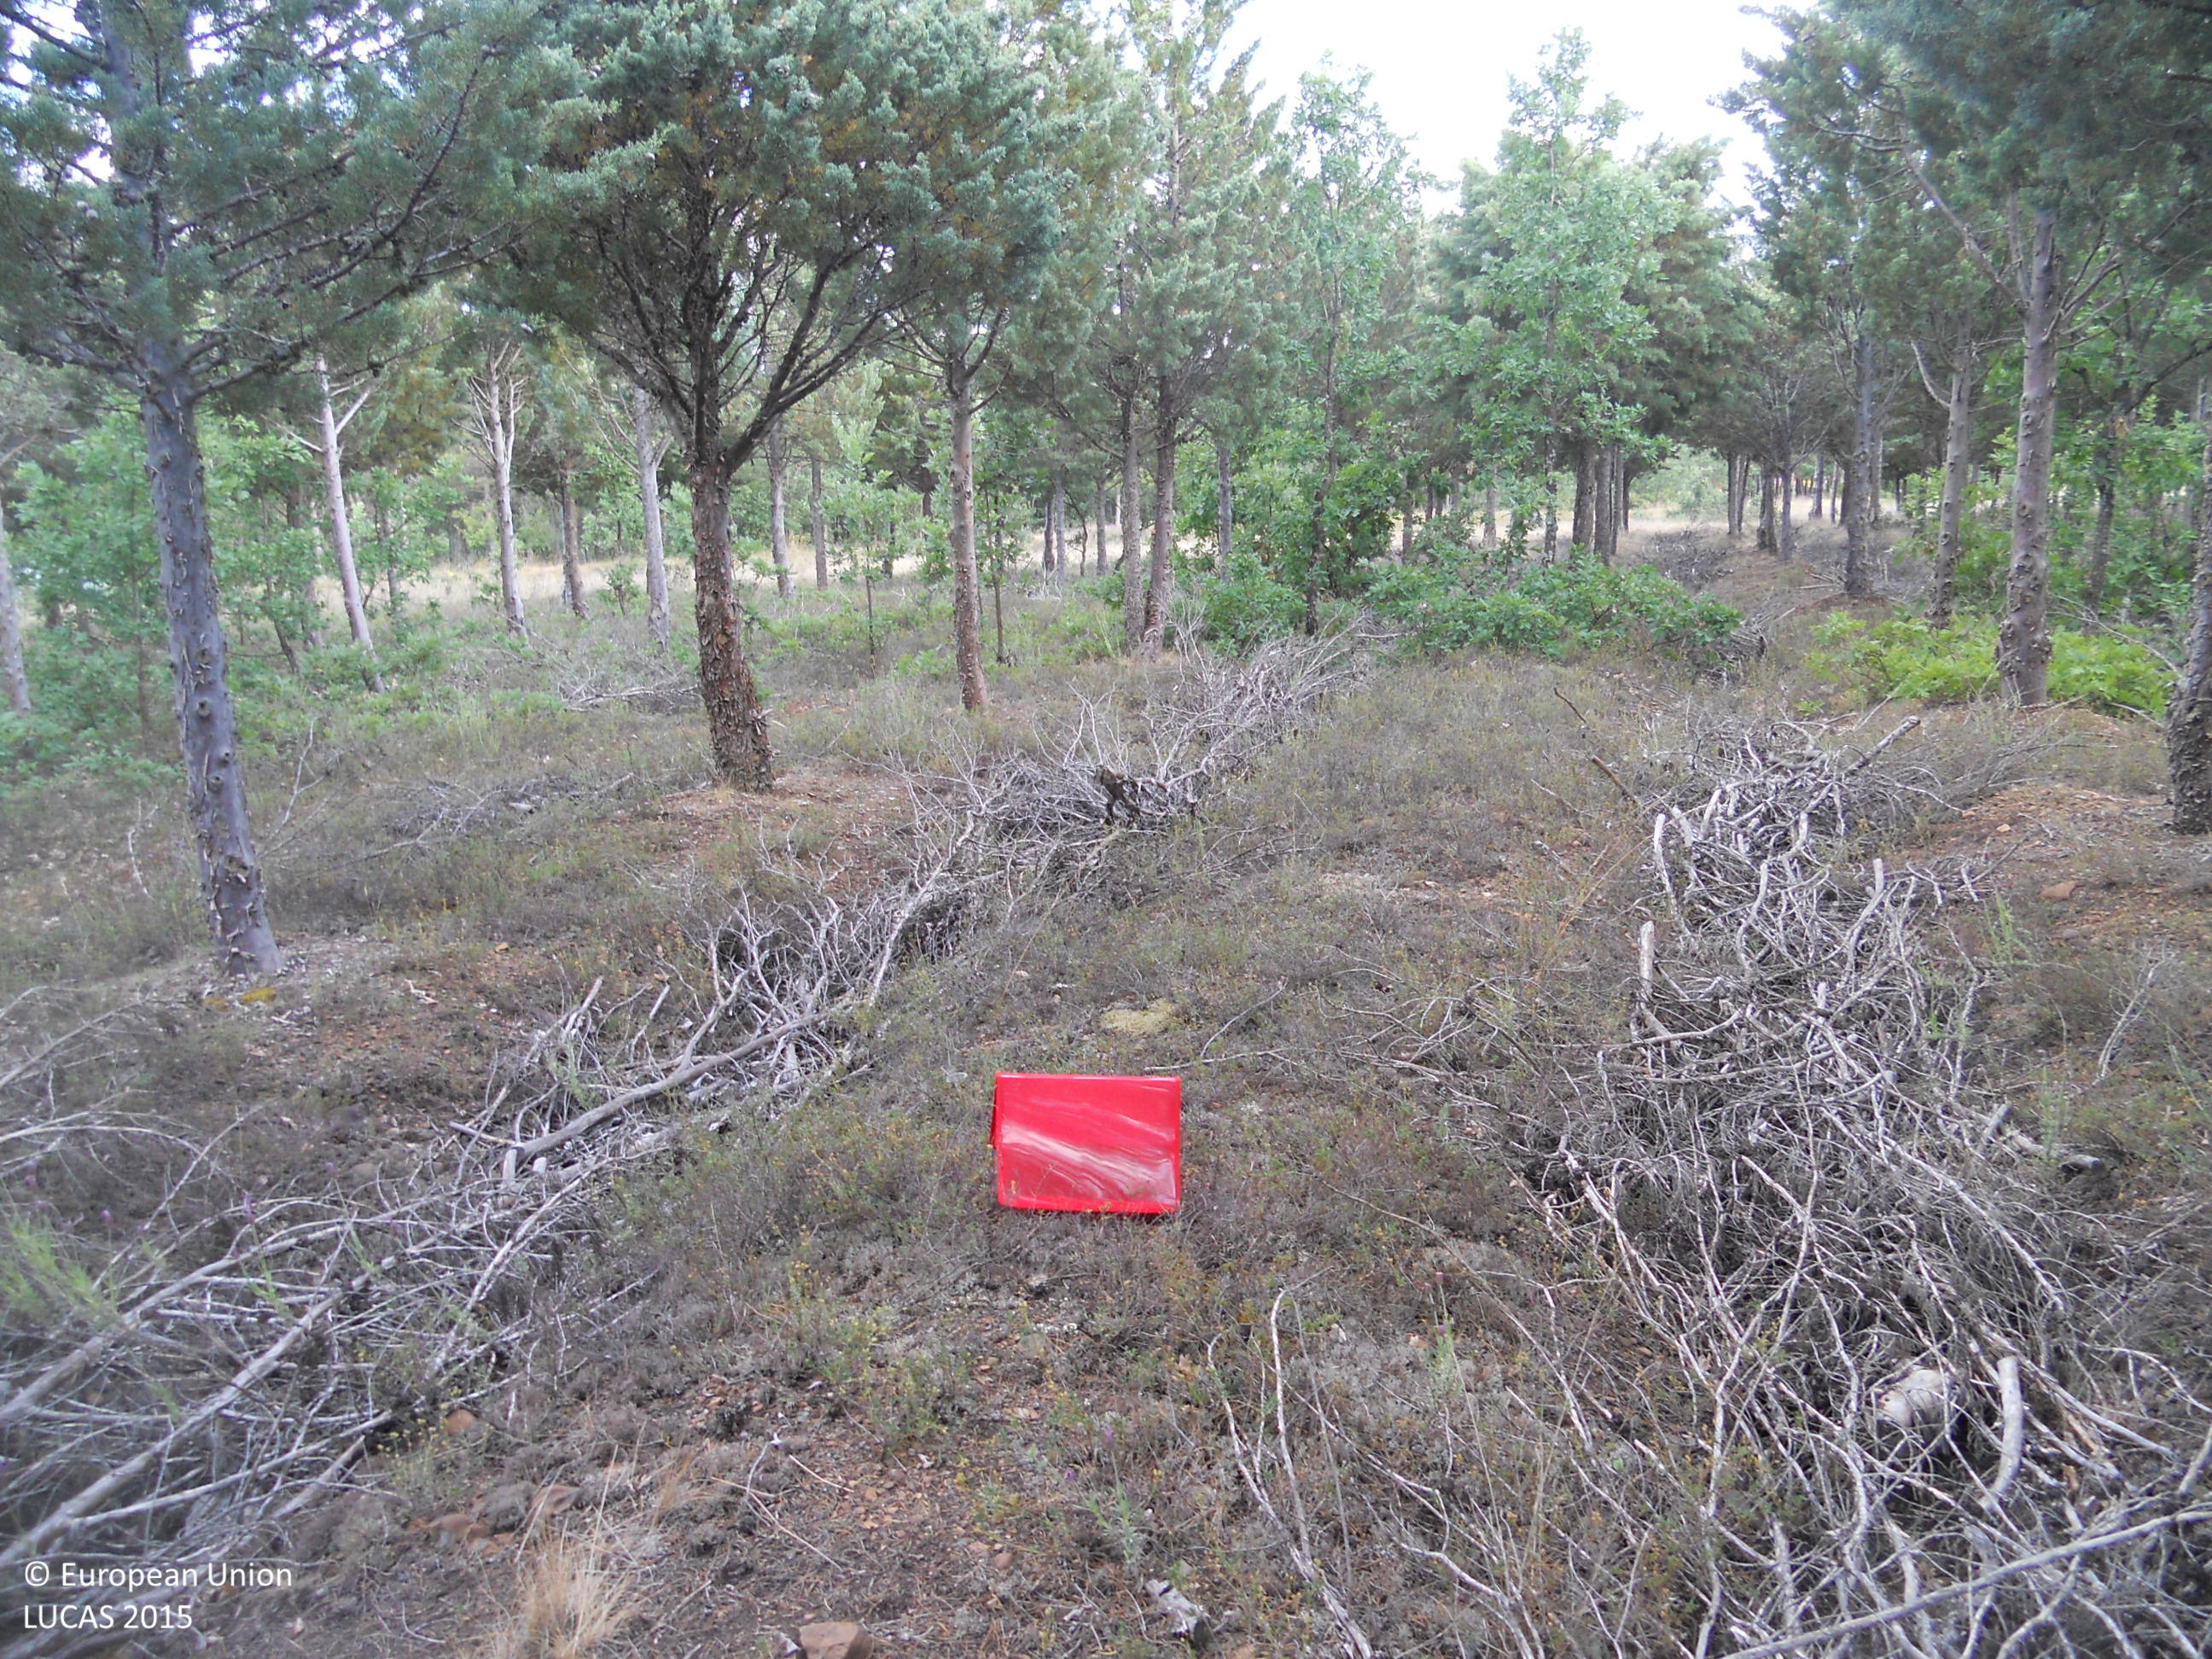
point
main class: Woodland
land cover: Other mixed woodland
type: acidophilous oak and oak-birch forest
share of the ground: > 75 %
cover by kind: broadleaved forest trees 35 %, herbaceous plants 20 %, coniferous forest trees 15 %, shrubs 5 %, unconsolidated bare surface 5 %
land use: Forestry
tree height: < 5 m
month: June
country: ES
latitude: 42.3616
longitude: -4.8320
